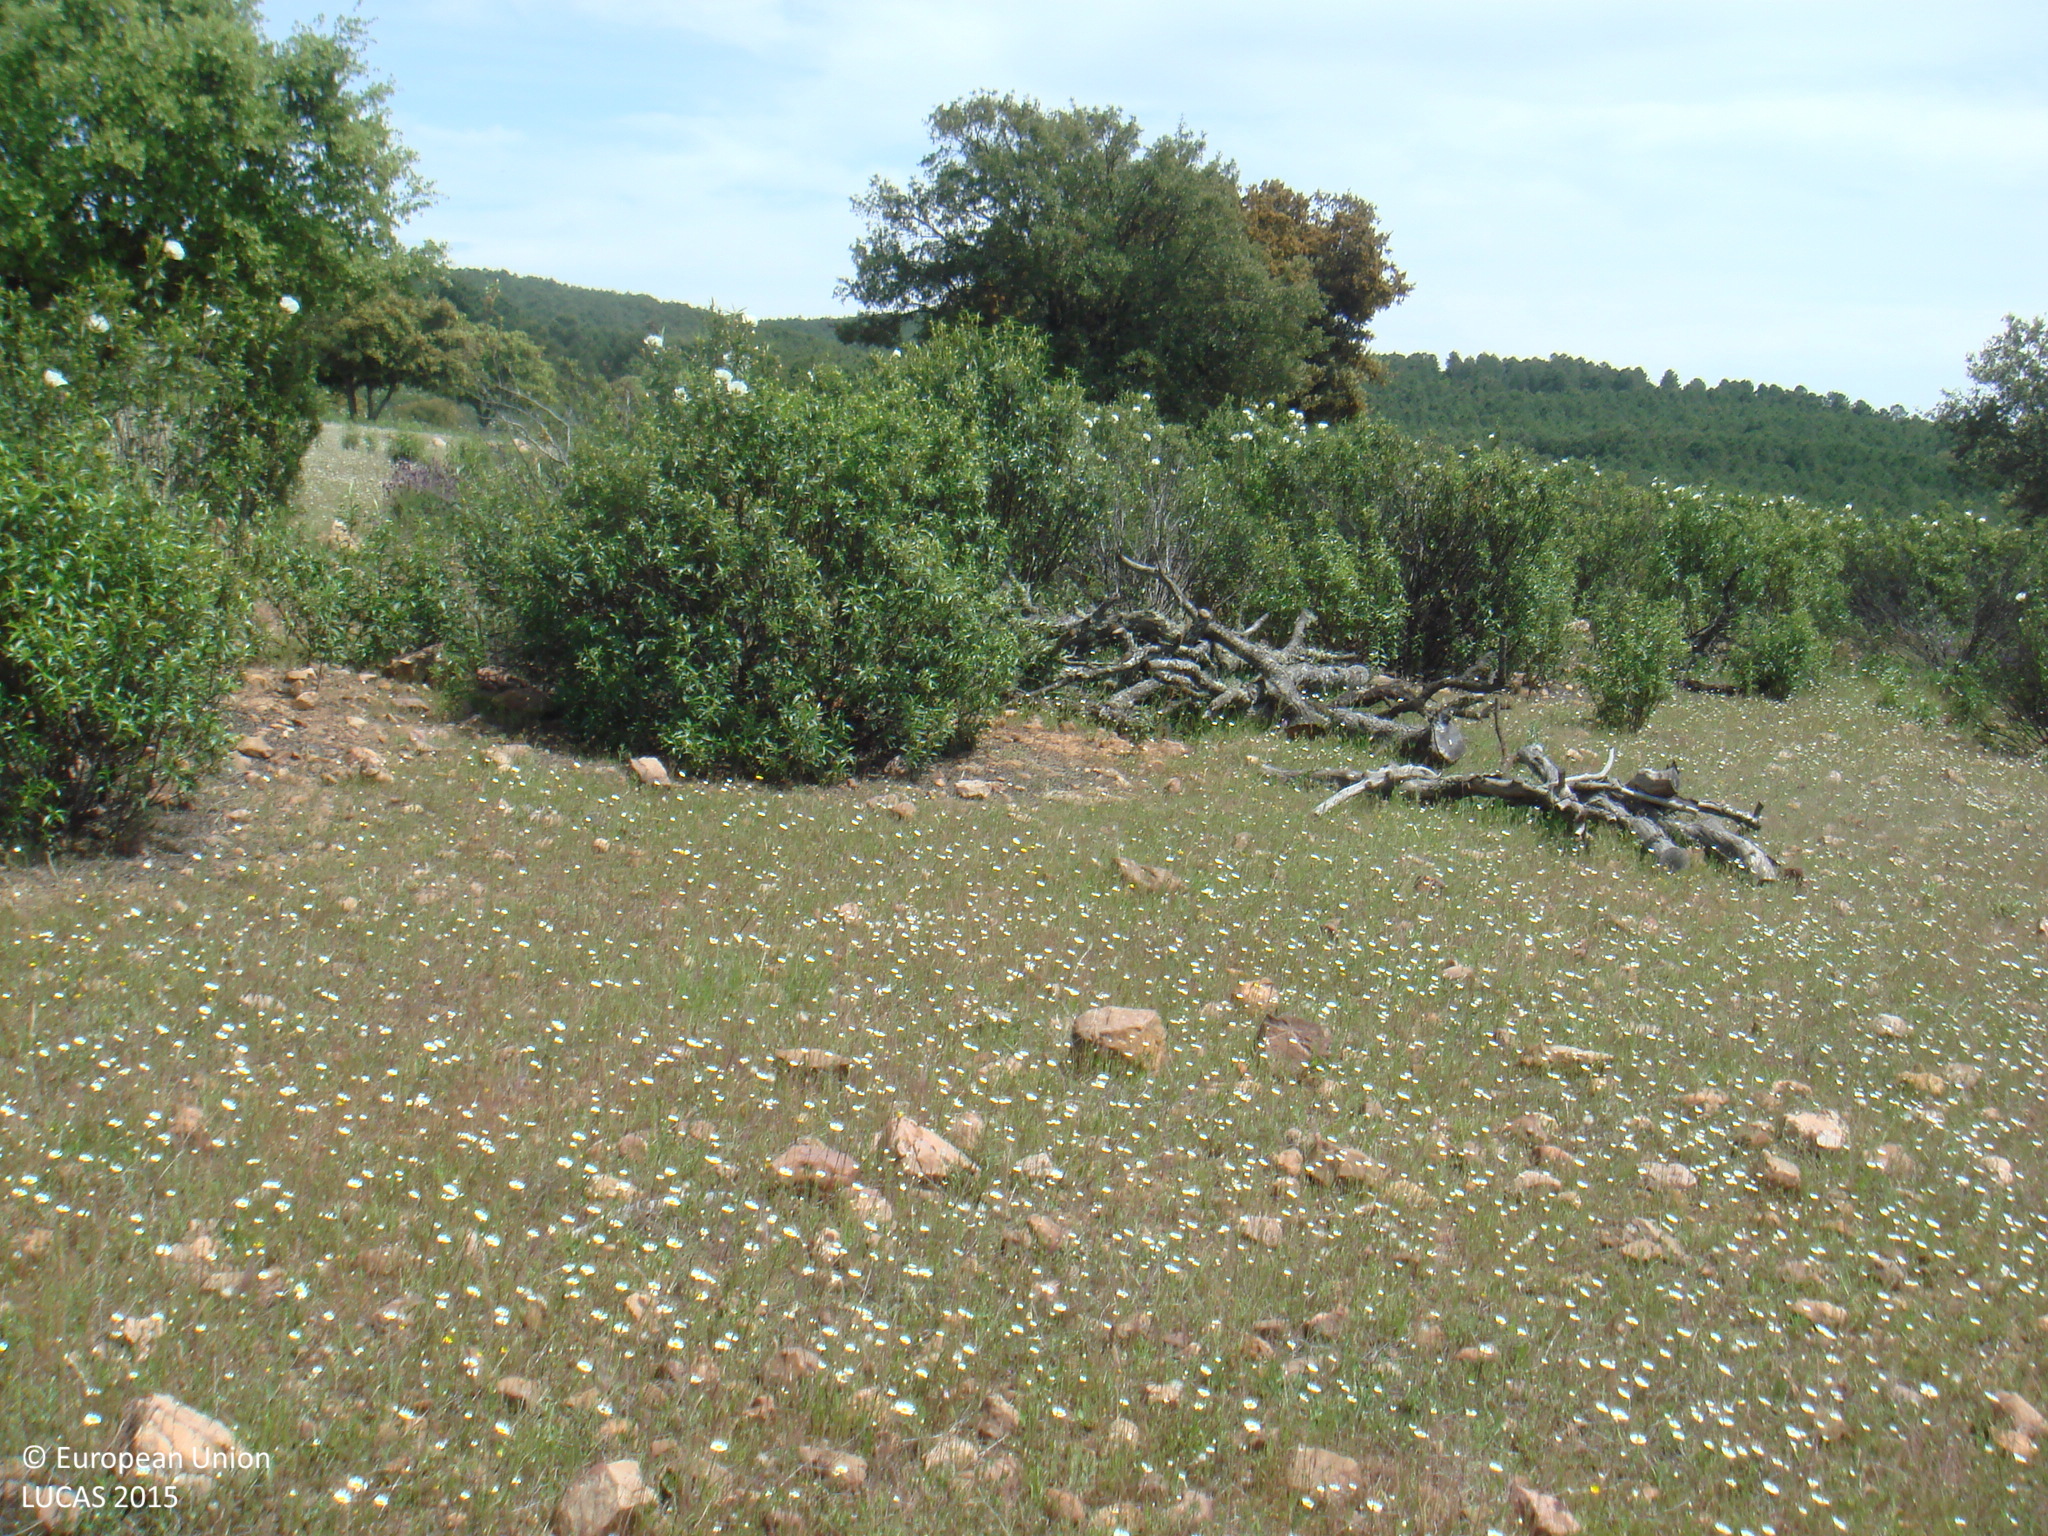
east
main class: Grassland
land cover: Spontaneously vegetated surfaces
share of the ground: > 75 %
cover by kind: herbaceous plants 75 %, unconsolidated bare surface 20 %, shrubs 5 %
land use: Agriculture (excluding fallow land and kitchen gardens)
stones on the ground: 10 - 25 %
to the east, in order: Spontaneously vegetated surfaces; Tracks; Broadleaved woodland; Spontaneously vegetated surfaces; Shrubland with sparse tree cover; Broadleaved woodland; Shrubland with sparse tree cover
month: May
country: ES
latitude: 38.2852
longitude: -5.0819
